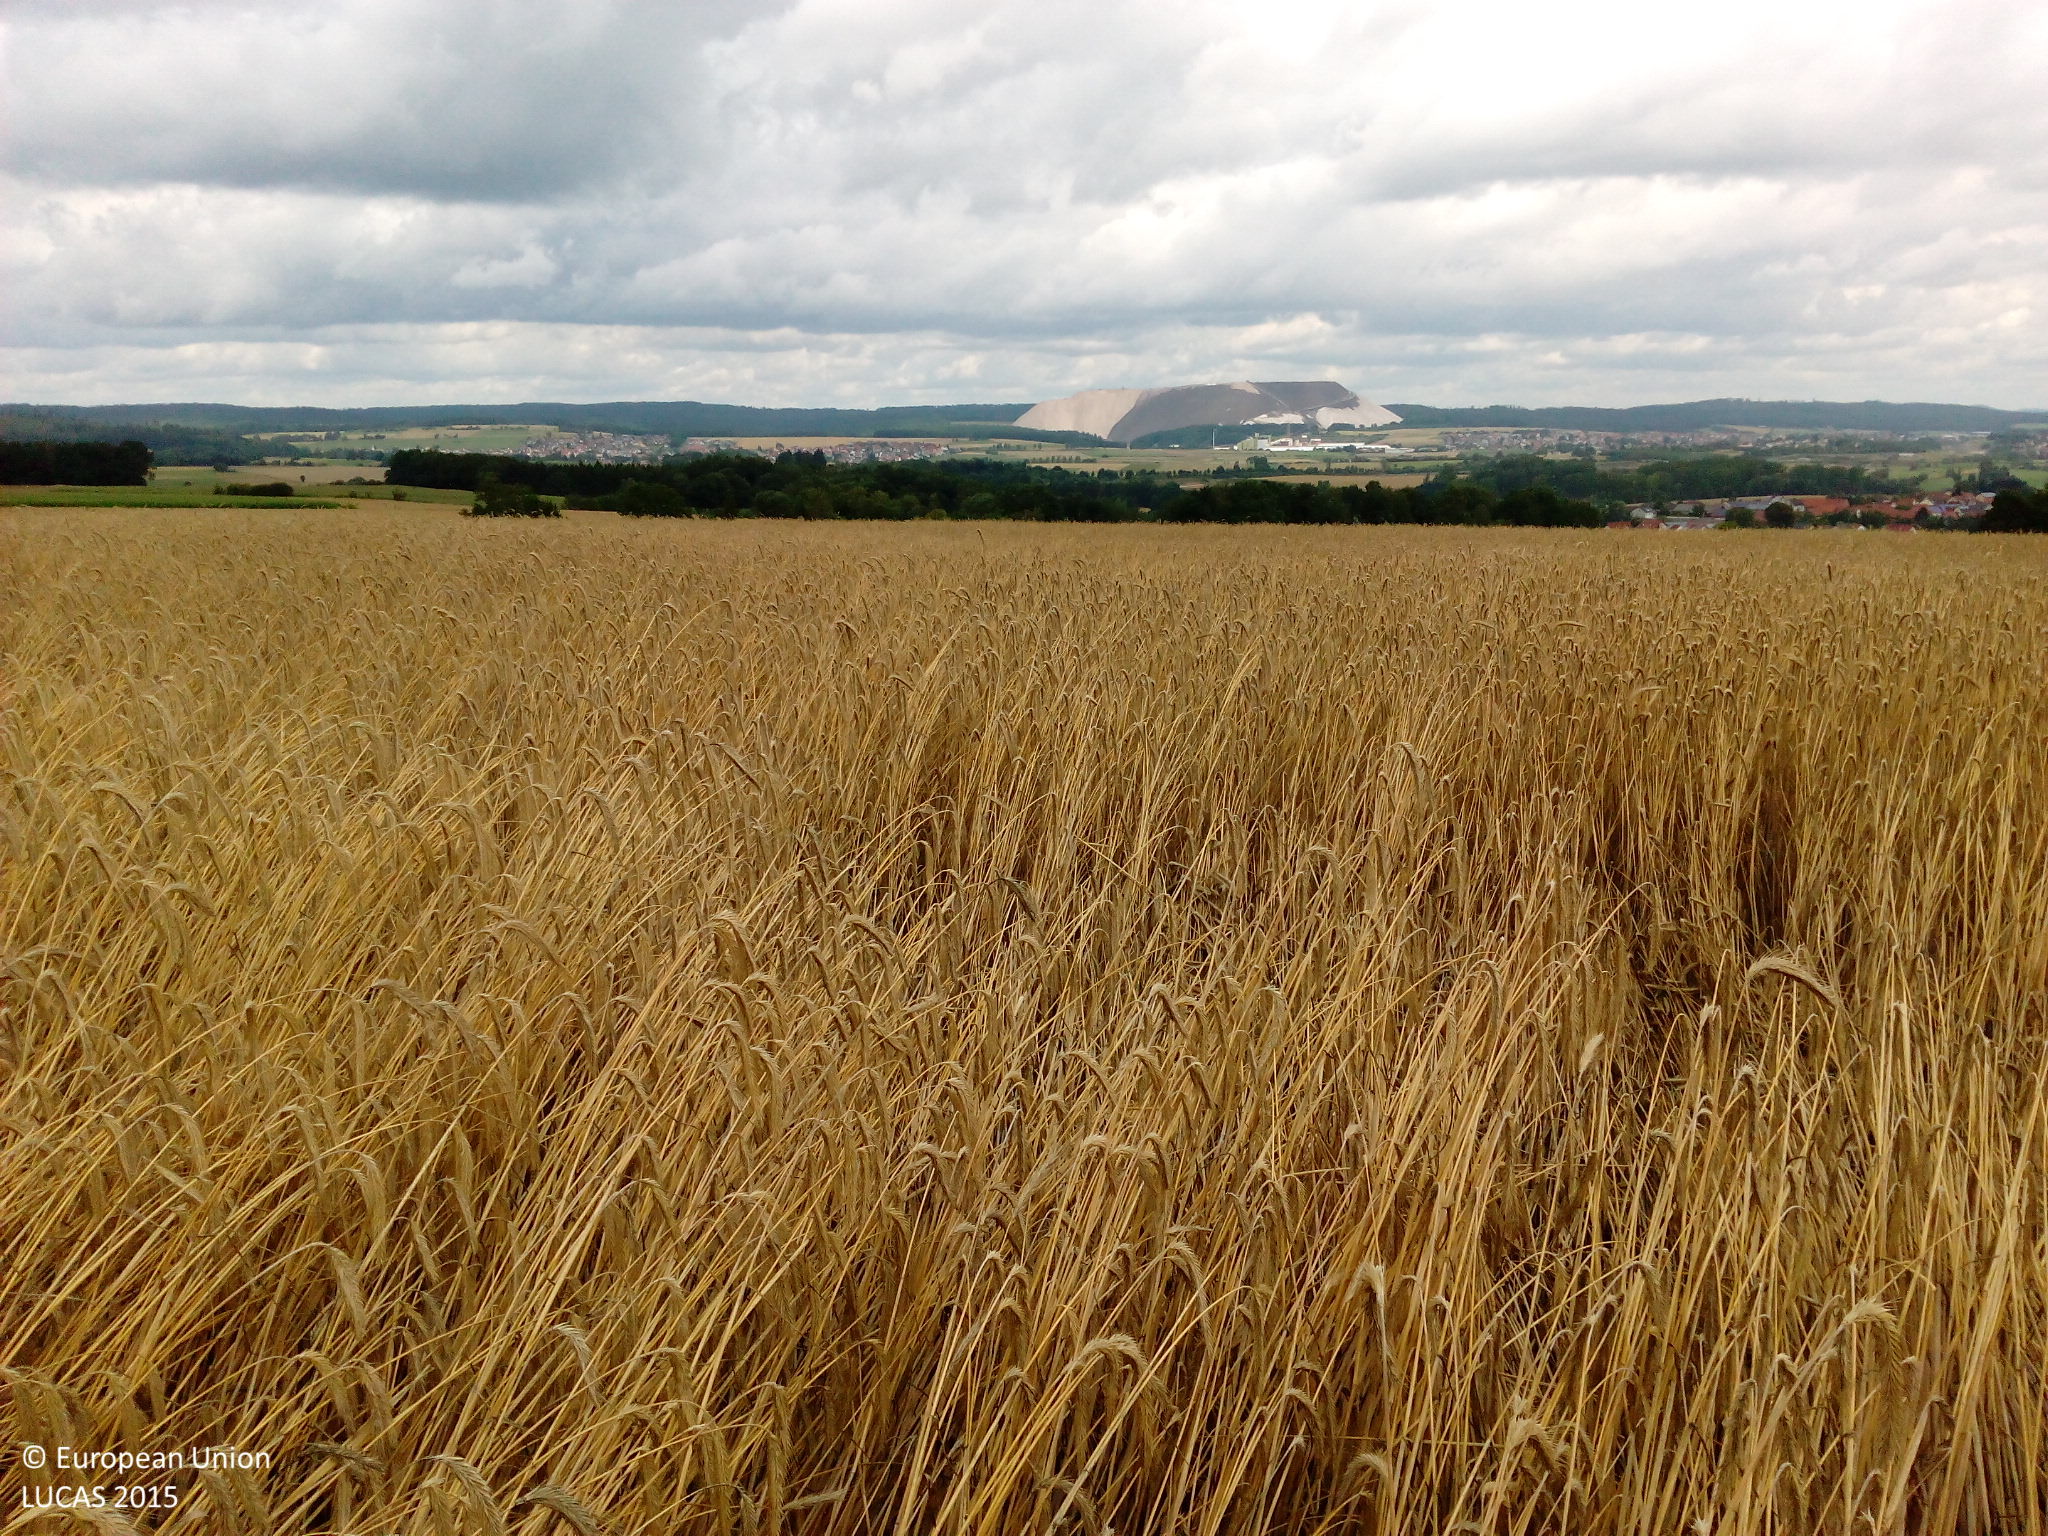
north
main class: Cropland
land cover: Triticale
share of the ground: > 75 %
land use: Agriculture (excluding fallow land and kitchen gardens)
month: July
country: DE
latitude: 50.4173
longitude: 9.5920
